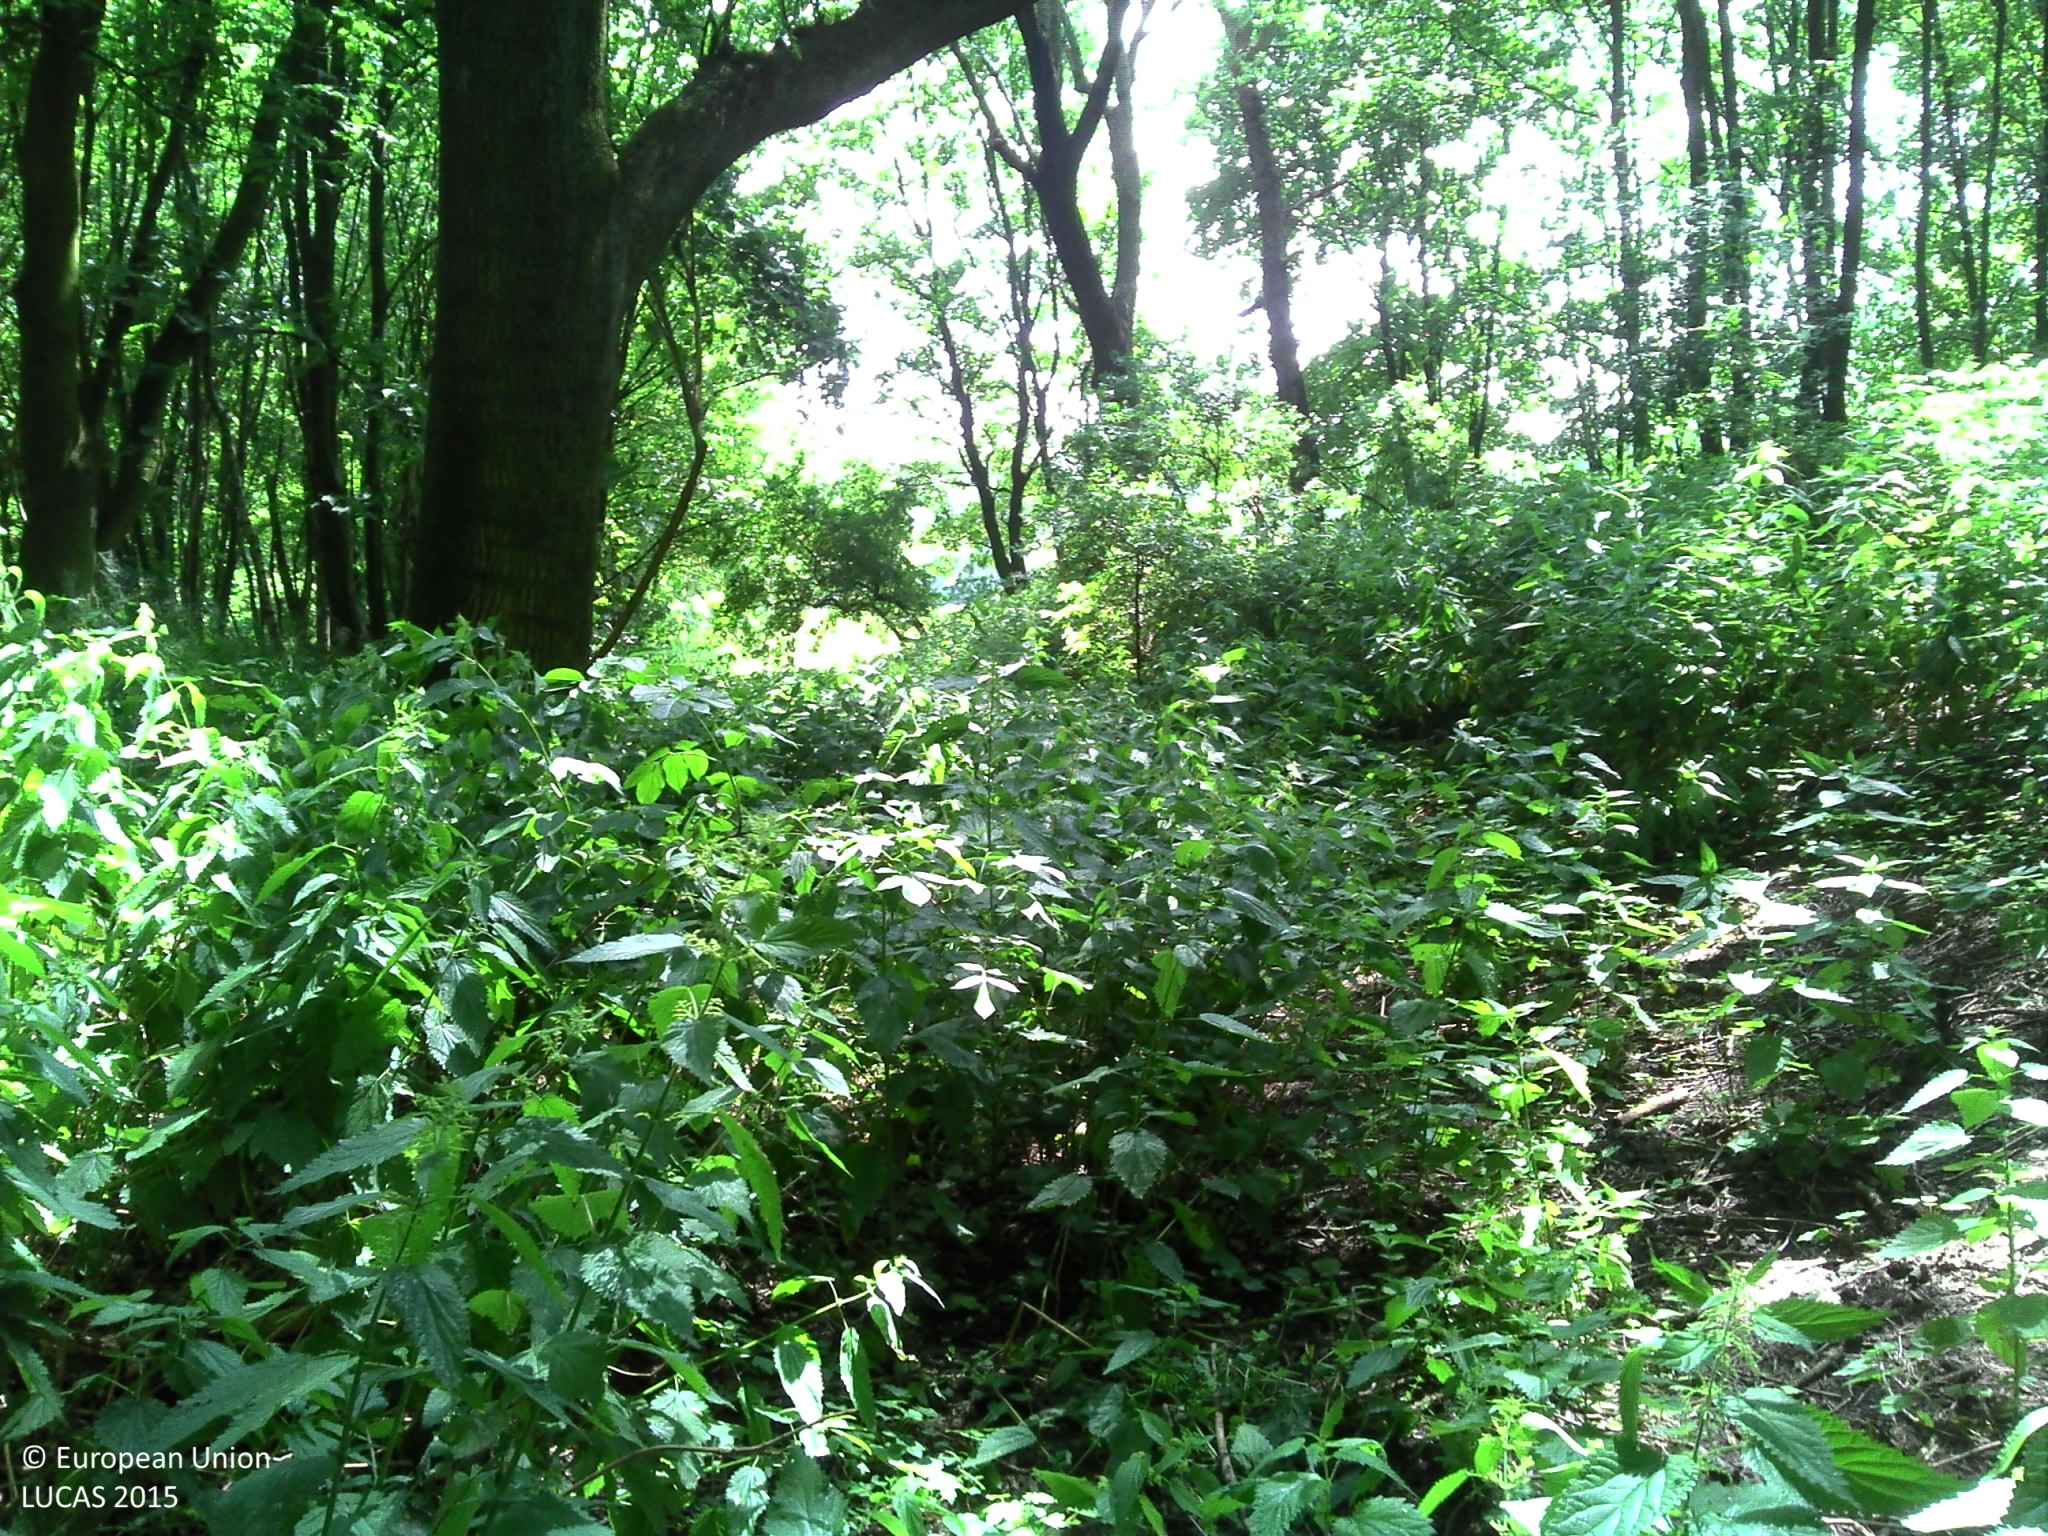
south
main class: Woodland
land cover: Broadleaved woodland
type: mesophytic deciduous forest
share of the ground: > 75 %
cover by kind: broadleaved forest trees 60 %, herbaceous plants 30 %, unconsolidated bare surface 10 %
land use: Forestry
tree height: > 5 m
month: June
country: BE
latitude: 50.4848
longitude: 3.8063
